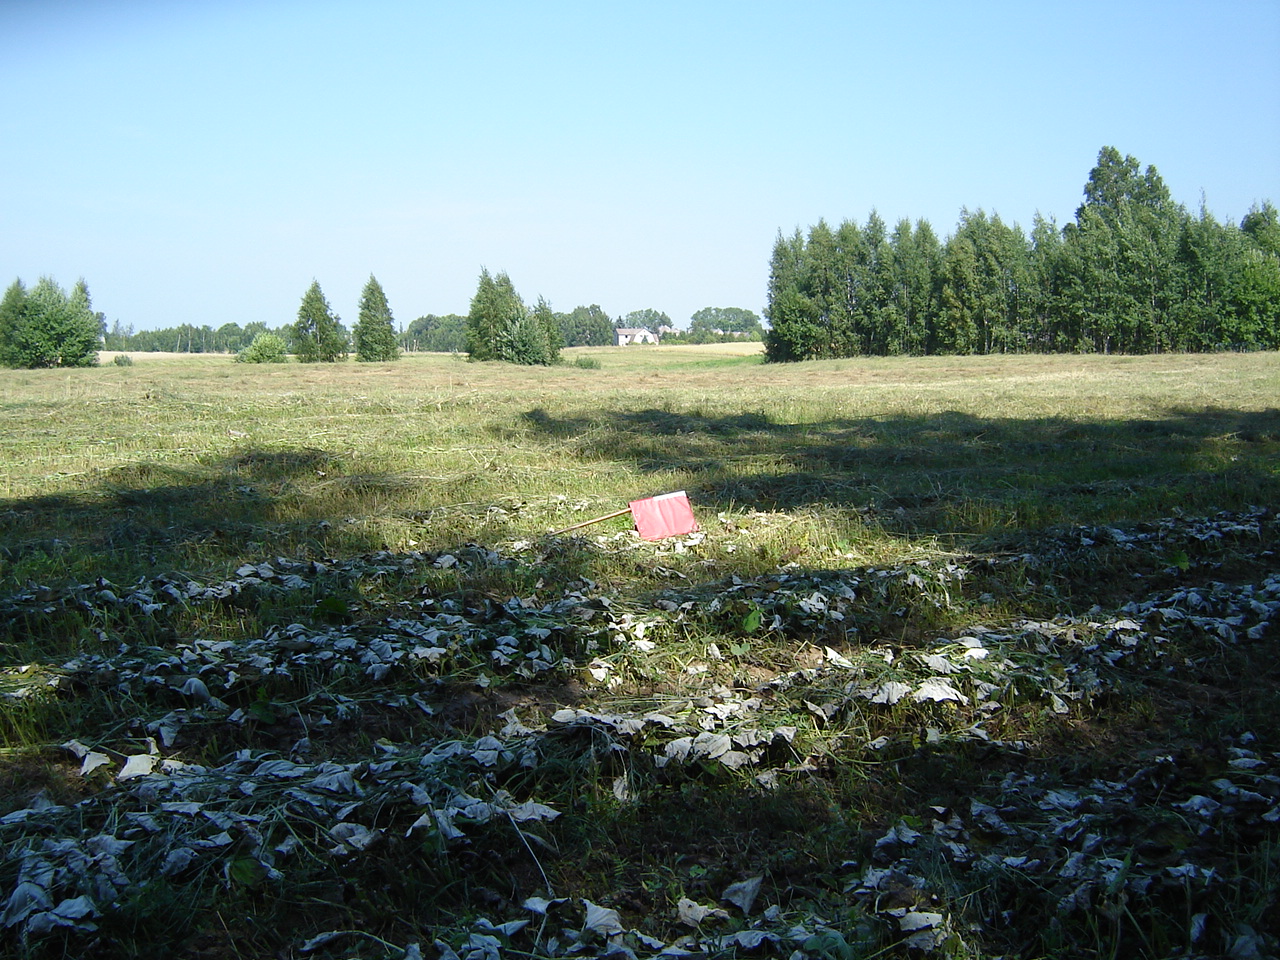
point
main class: Grassland
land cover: Grassland without tree/shrub cover
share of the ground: > 75 %
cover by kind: herbaceous plants 100 %
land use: Agriculture (excluding fallow land and kitchen gardens)
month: August
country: LT
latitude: 55.2078
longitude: 24.9942
